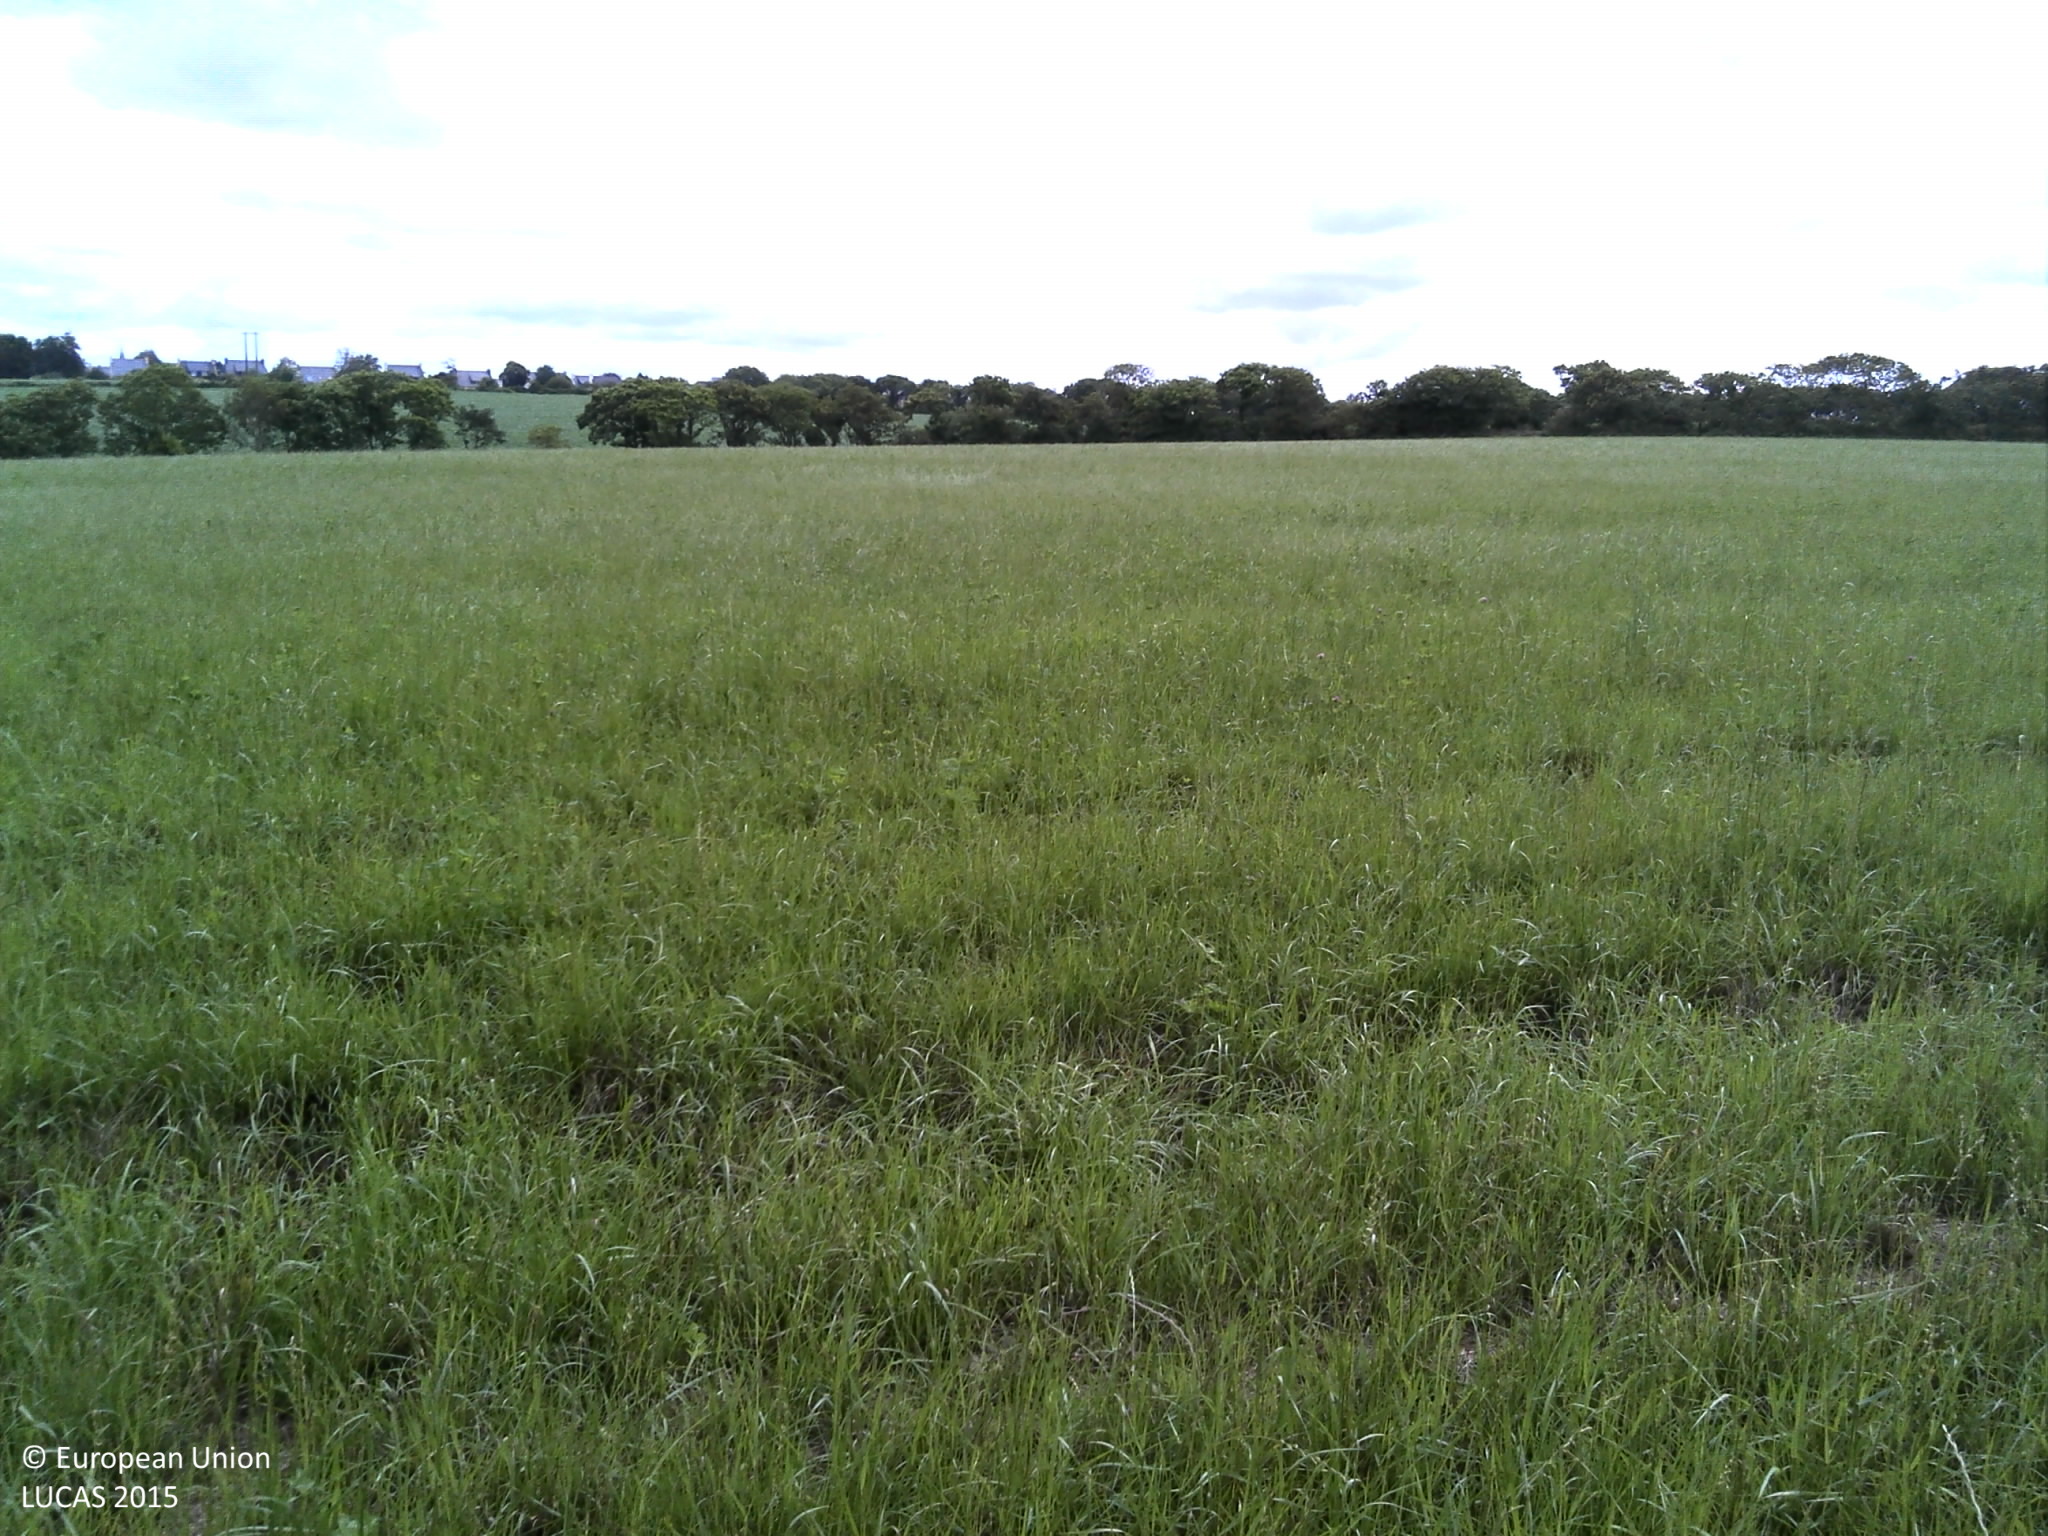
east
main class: Cropland
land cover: Temporary grasslands
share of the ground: > 75 %
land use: Agriculture (excluding fallow land and kitchen gardens)
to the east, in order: Temporary grasslands; Managed hedges; Tracks; Managed hedges; Maize
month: July
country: FR
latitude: 48.4187
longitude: -4.5718
